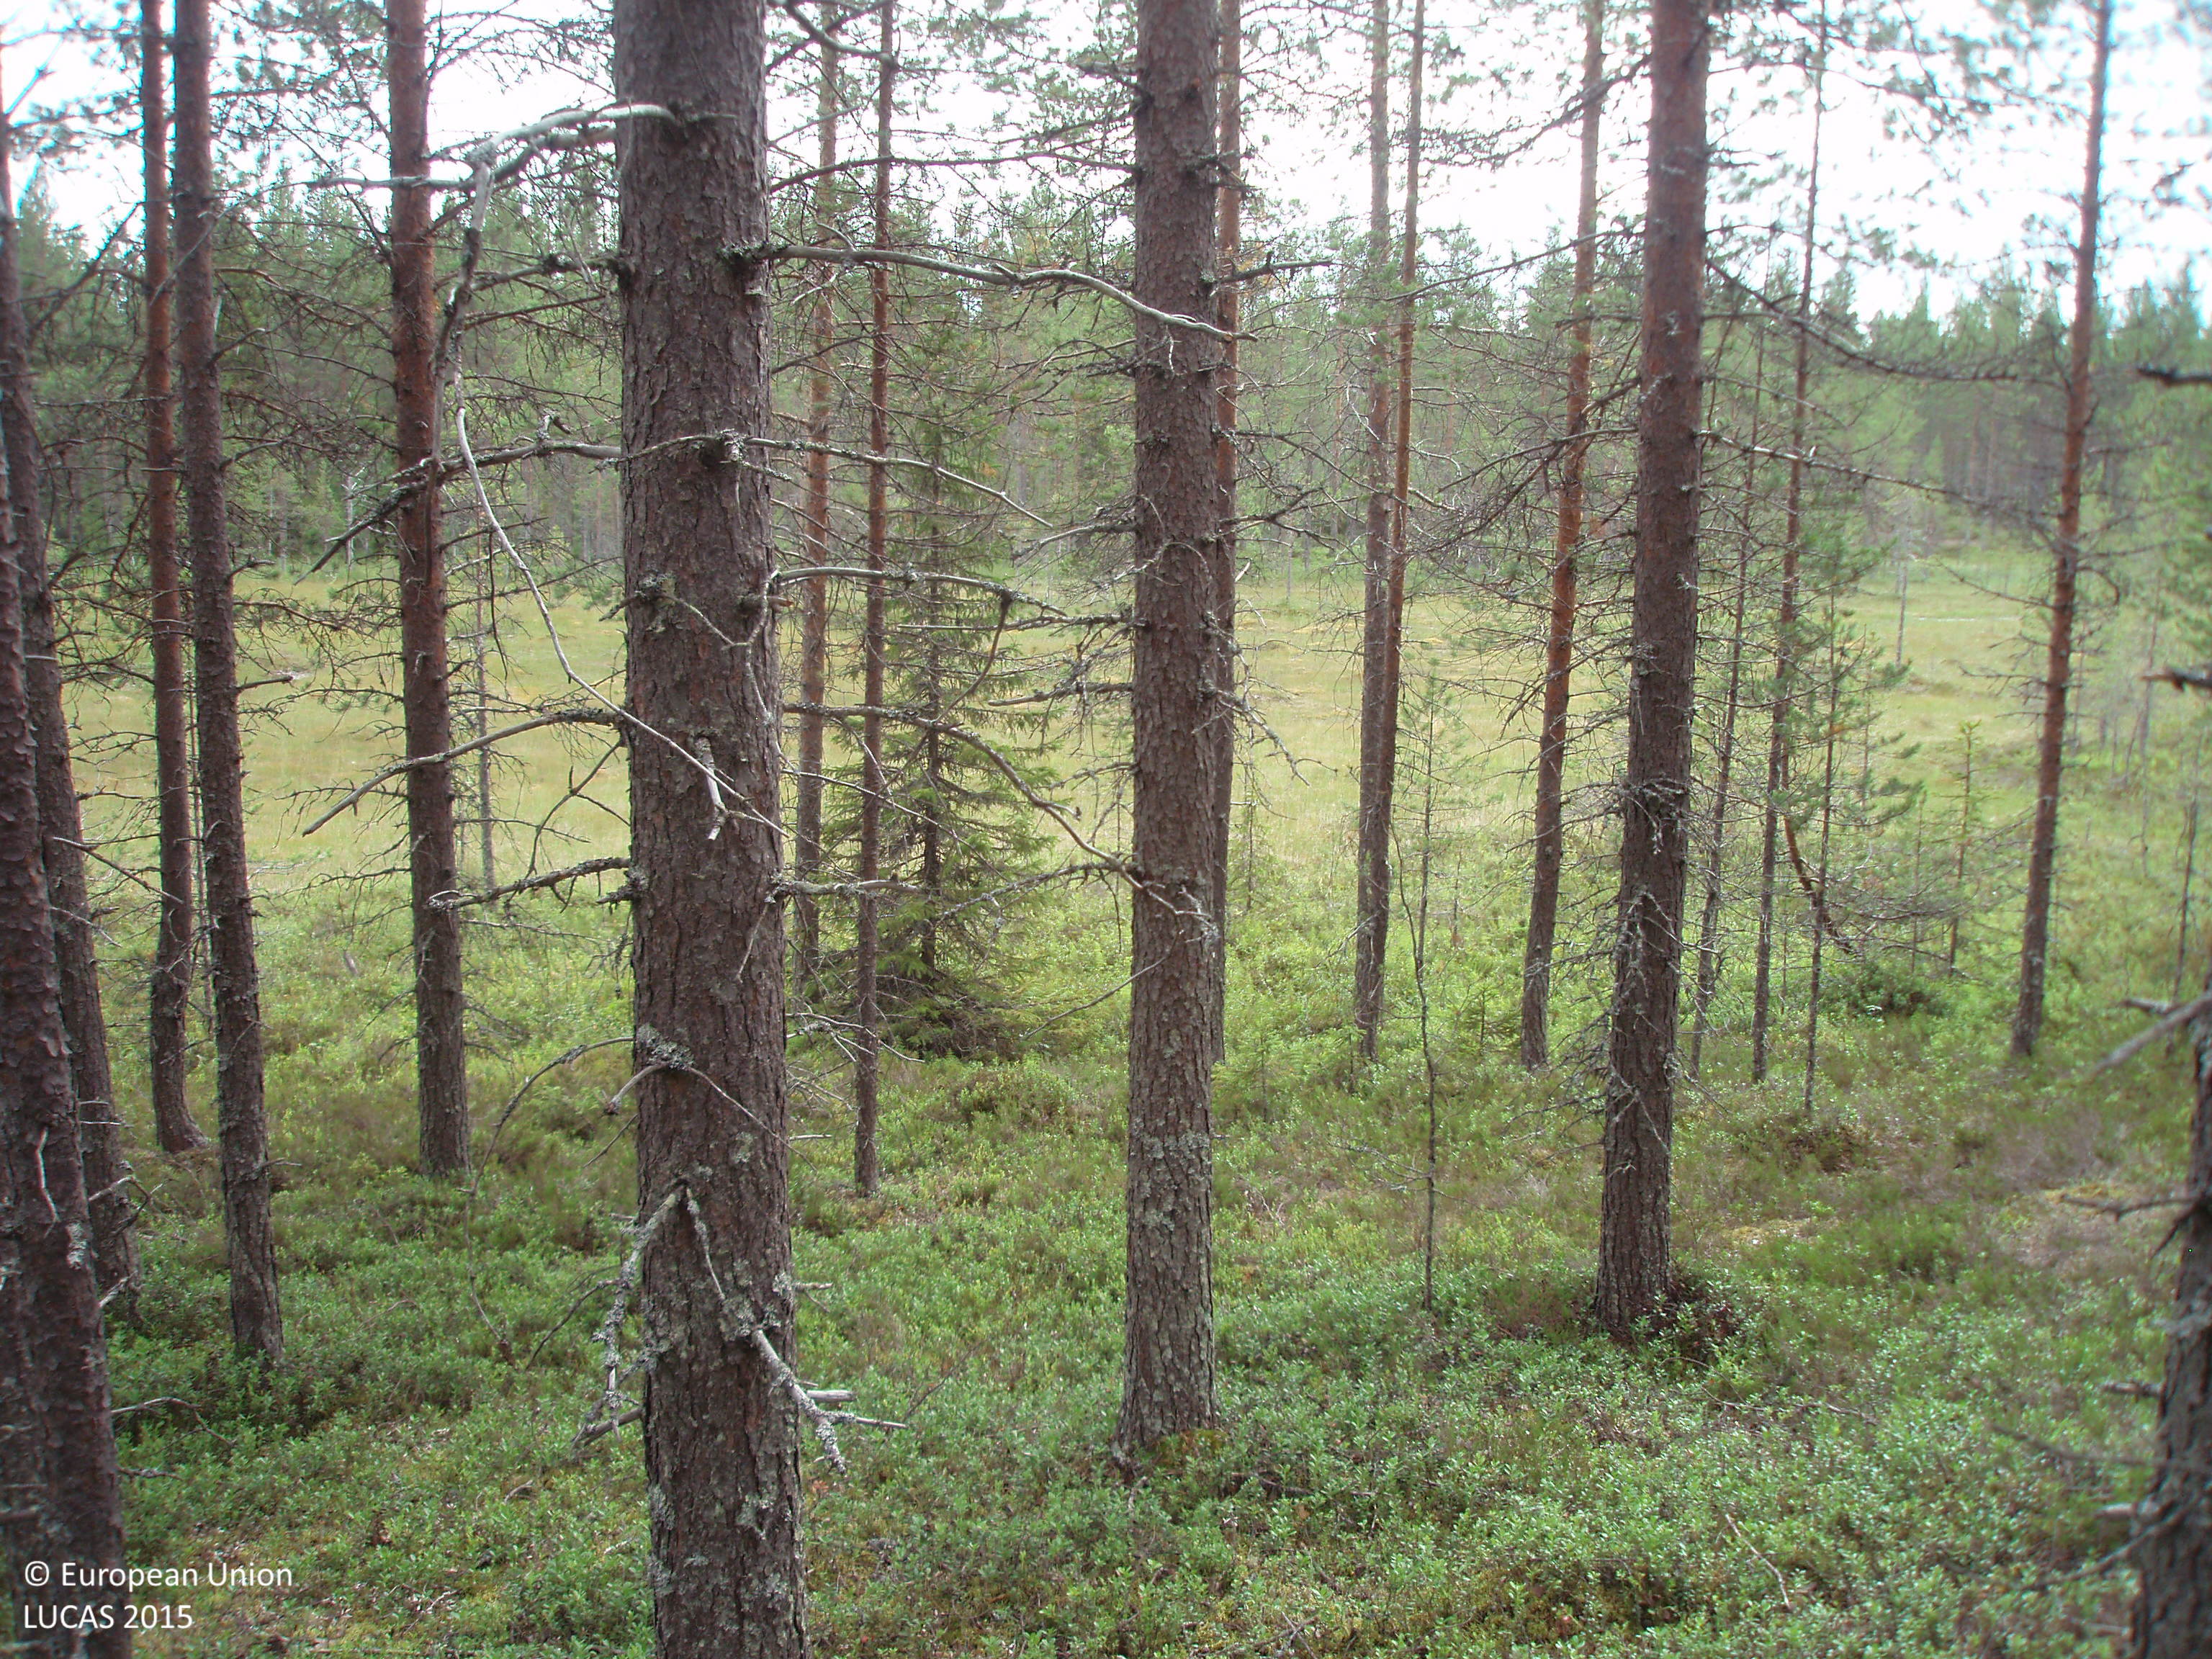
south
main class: Woodland
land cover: Pine dominated coniferous woodland
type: boreal forest
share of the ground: 50 - 75 %
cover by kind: coniferous forest trees 70 %, shrubs 30 %
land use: Forestry
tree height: > 5 m
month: July
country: FI
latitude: 65.6831
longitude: 27.6959
